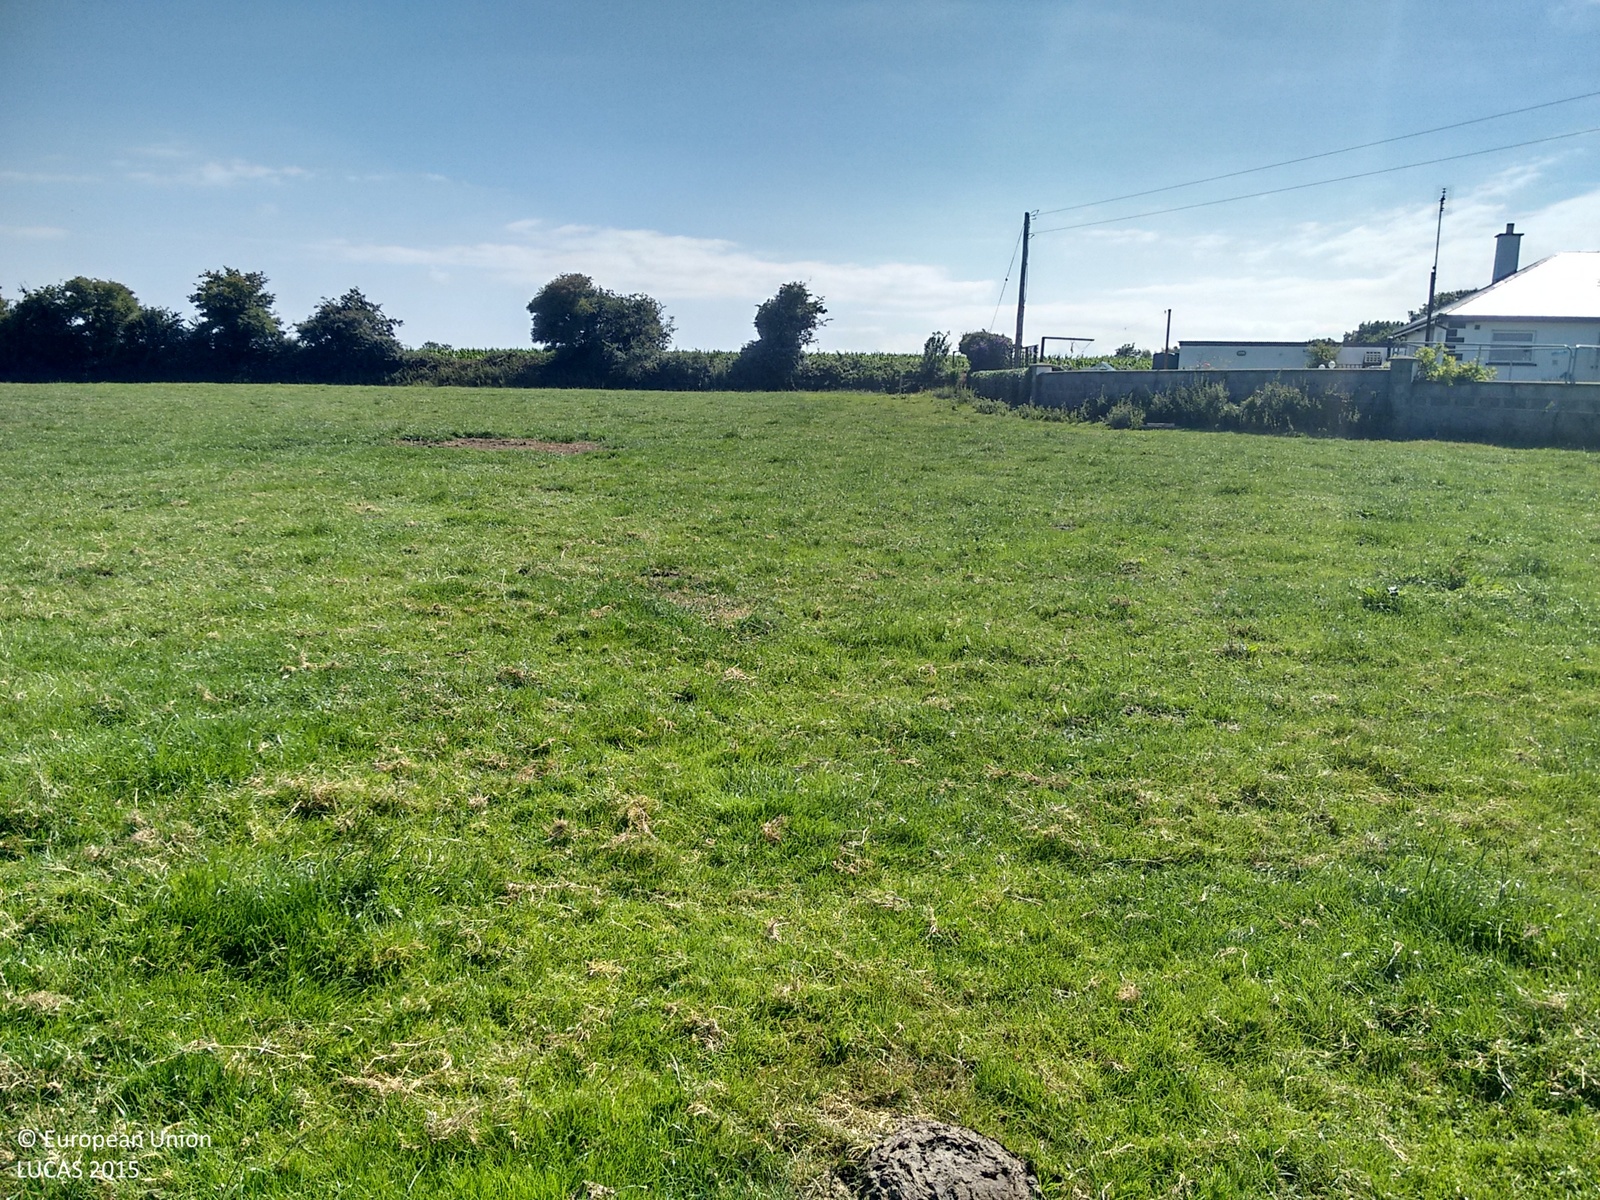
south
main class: Grassland
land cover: Grassland without tree/shrub cover
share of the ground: > 75 %
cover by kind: herbaceous plants 100 %
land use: Agriculture (excluding fallow land and kitchen gardens)
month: August
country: IE
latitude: 53.8120
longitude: -6.2945
